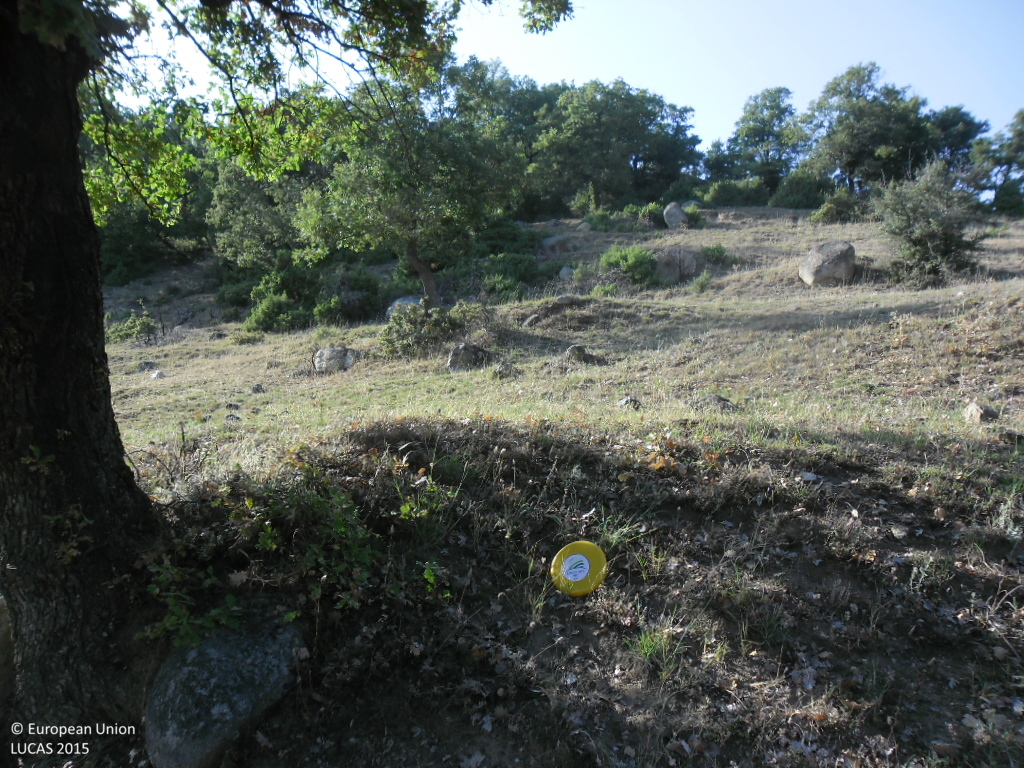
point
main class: Grassland
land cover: Grassland with sparse tree/shrub cover
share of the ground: > 75 %
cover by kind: herbaceous plants 90 %, broadleaved forest trees 5 %, shrubs 5 %
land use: Agriculture (excluding fallow land and kitchen gardens)
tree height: < 5 m
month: September
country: BG
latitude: 41.6250
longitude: 23.3098
